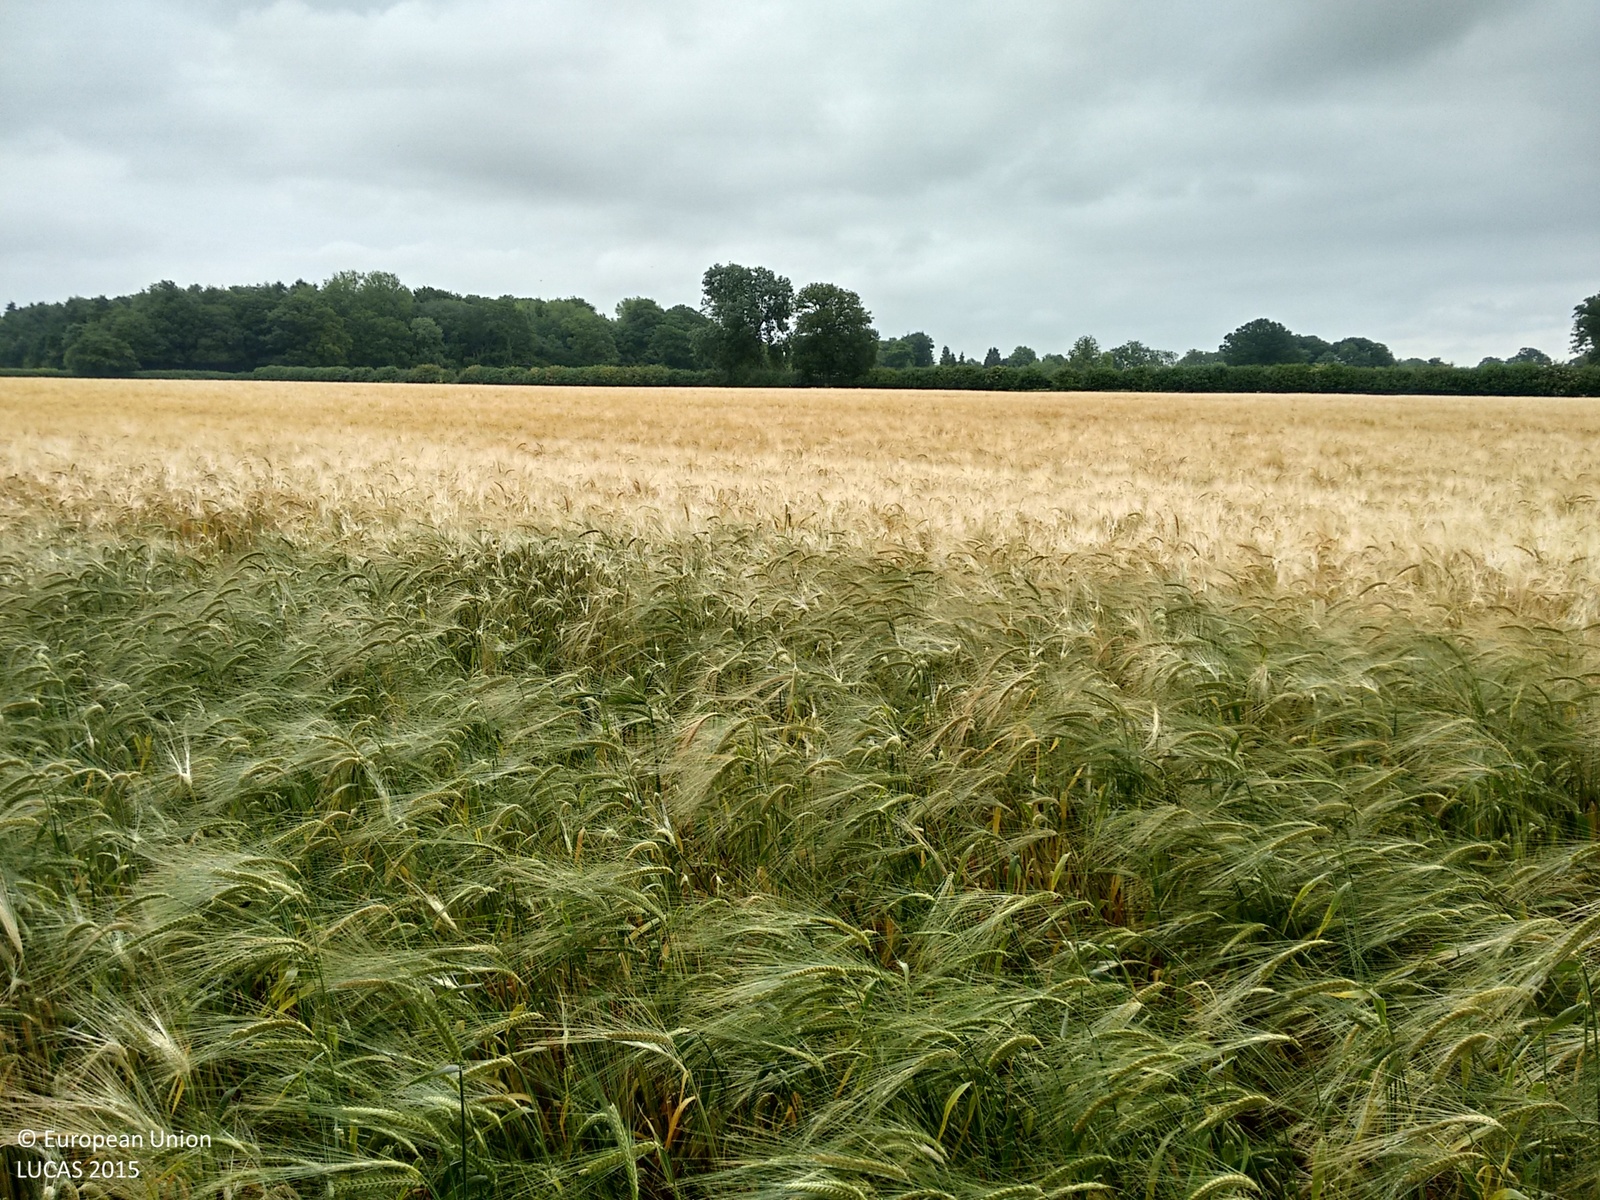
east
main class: Cropland
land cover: Barley
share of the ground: > 75 %
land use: Agriculture (excluding fallow land and kitchen gardens)
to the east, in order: Single bushes/trees; Grass margins; Barley; Grass margins; Managed hedges; Grass margins; Barley
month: July
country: GB
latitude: 51.5159
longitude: -1.0402
